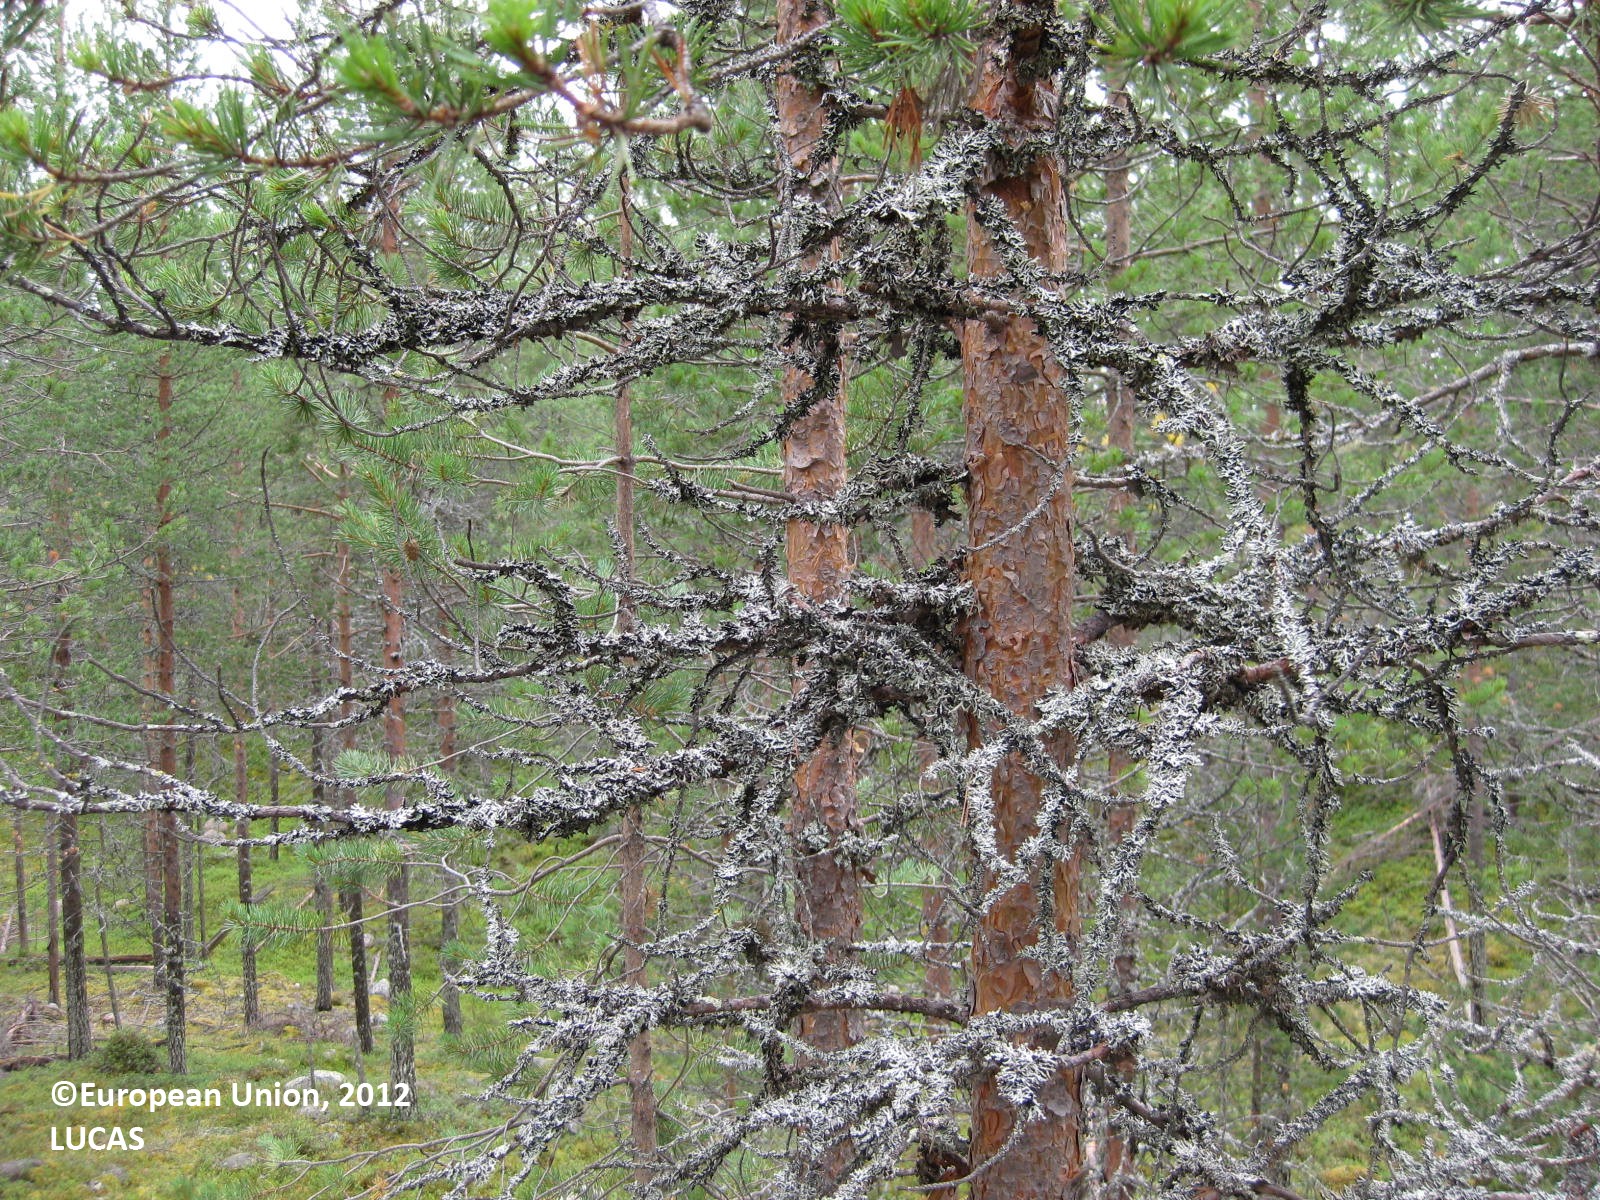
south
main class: Woodland
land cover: Pine dominated coniferous woodland
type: boreal forest
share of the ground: 50 - 75 %
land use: Forestry
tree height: > 5 m
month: August
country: FI
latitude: 66.0073
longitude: 28.1483
